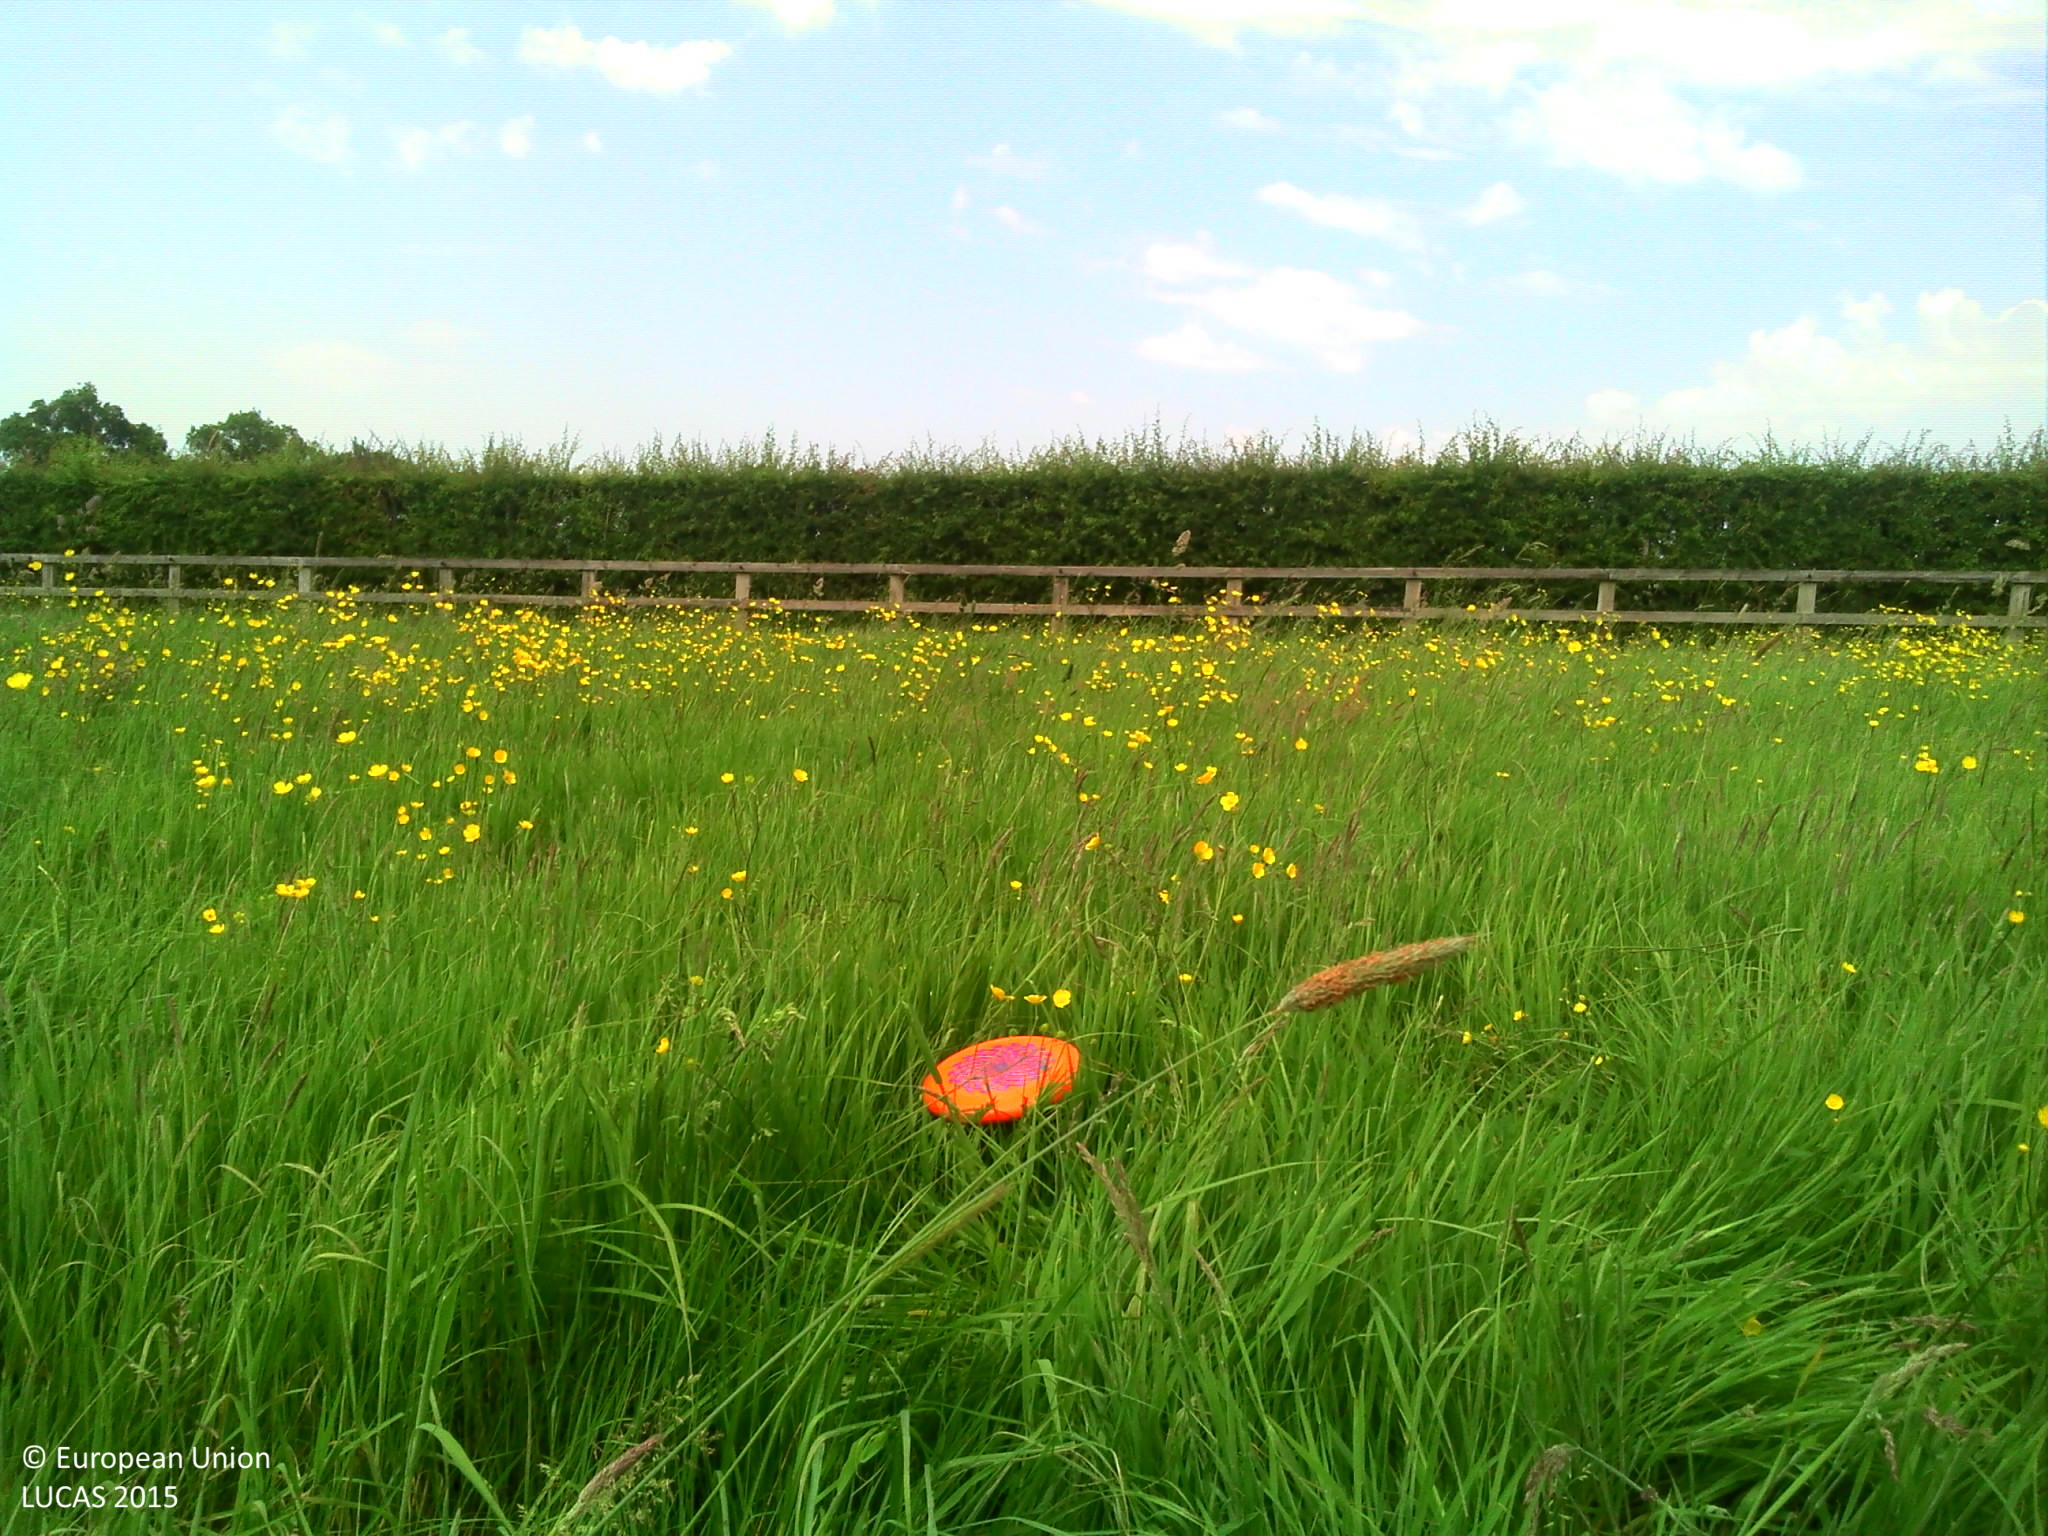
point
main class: Grassland
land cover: Grassland without tree/shrub cover
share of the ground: > 75 %
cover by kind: herbaceous plants 95 %
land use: Agriculture (excluding fallow land and kitchen gardens)
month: June
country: FR
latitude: 48.7257
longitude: 0.1701
